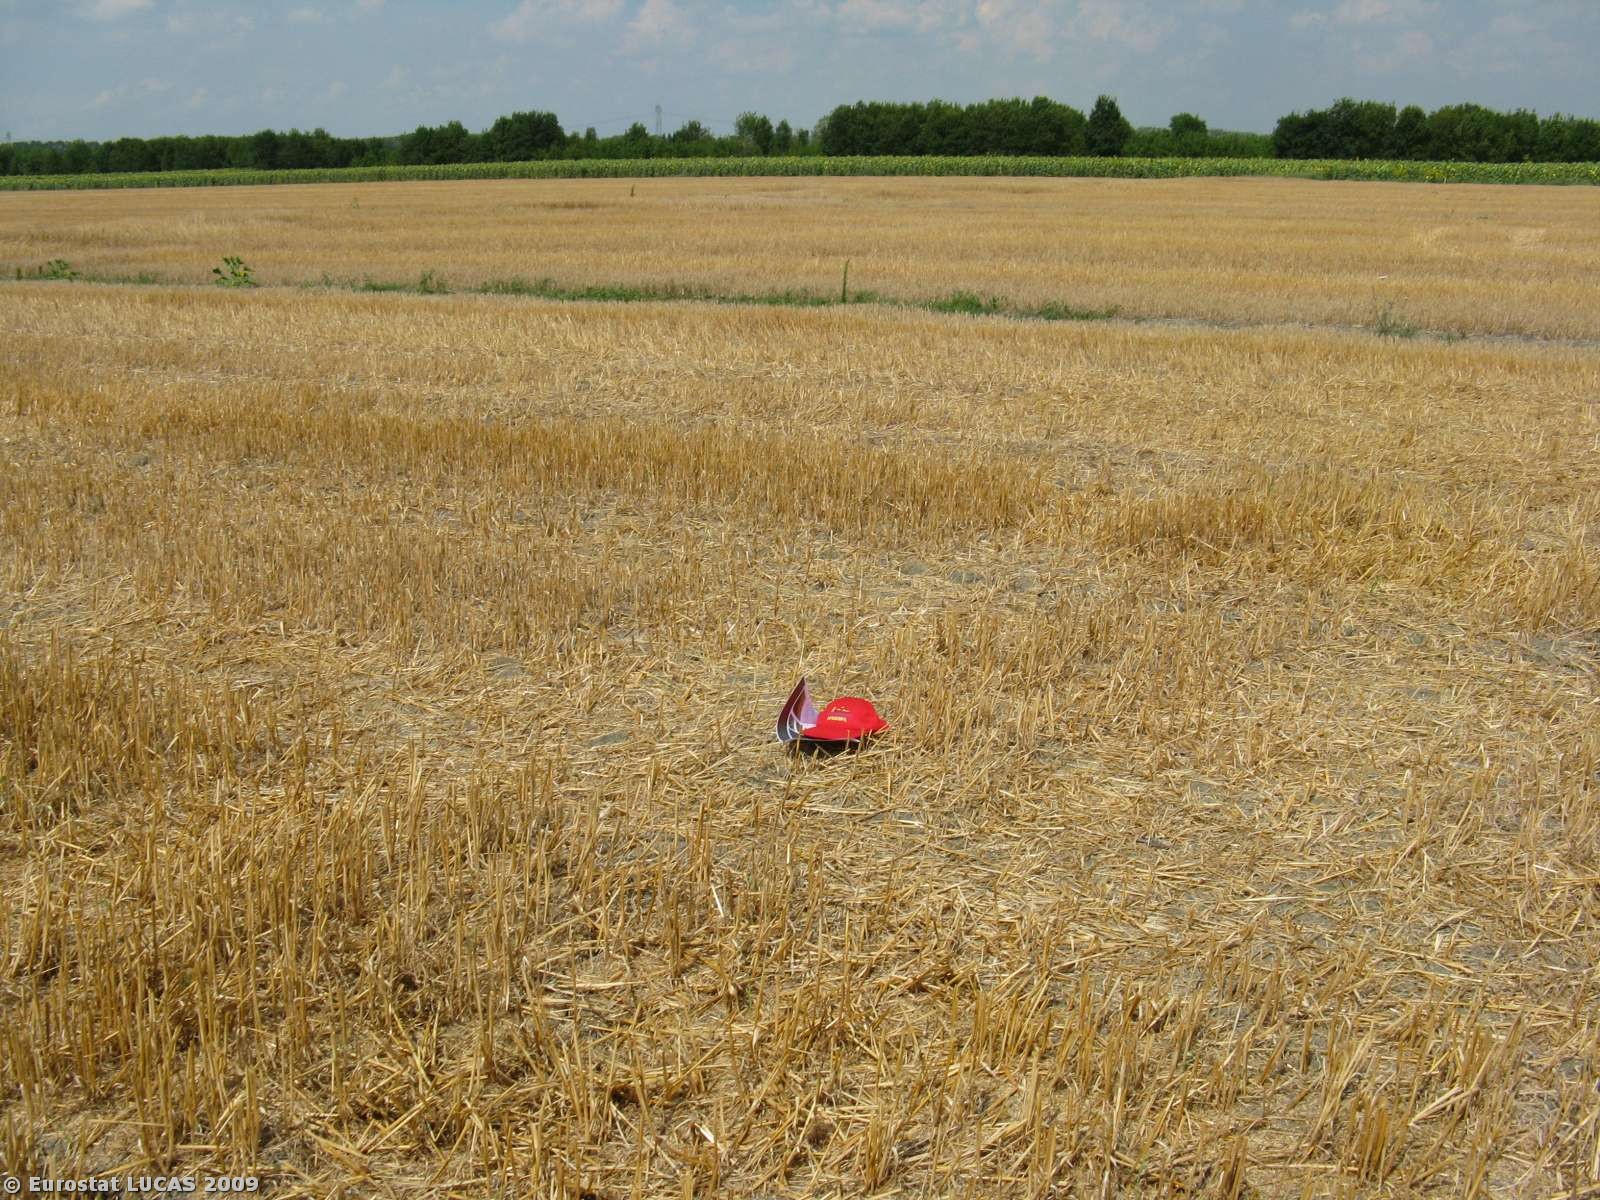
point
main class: Cropland
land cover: Common wheat
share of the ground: < 10 %
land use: Agriculture (excluding fallow land and kitchen gardens)
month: July
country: IT
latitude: 44.5540
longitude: 11.6456
